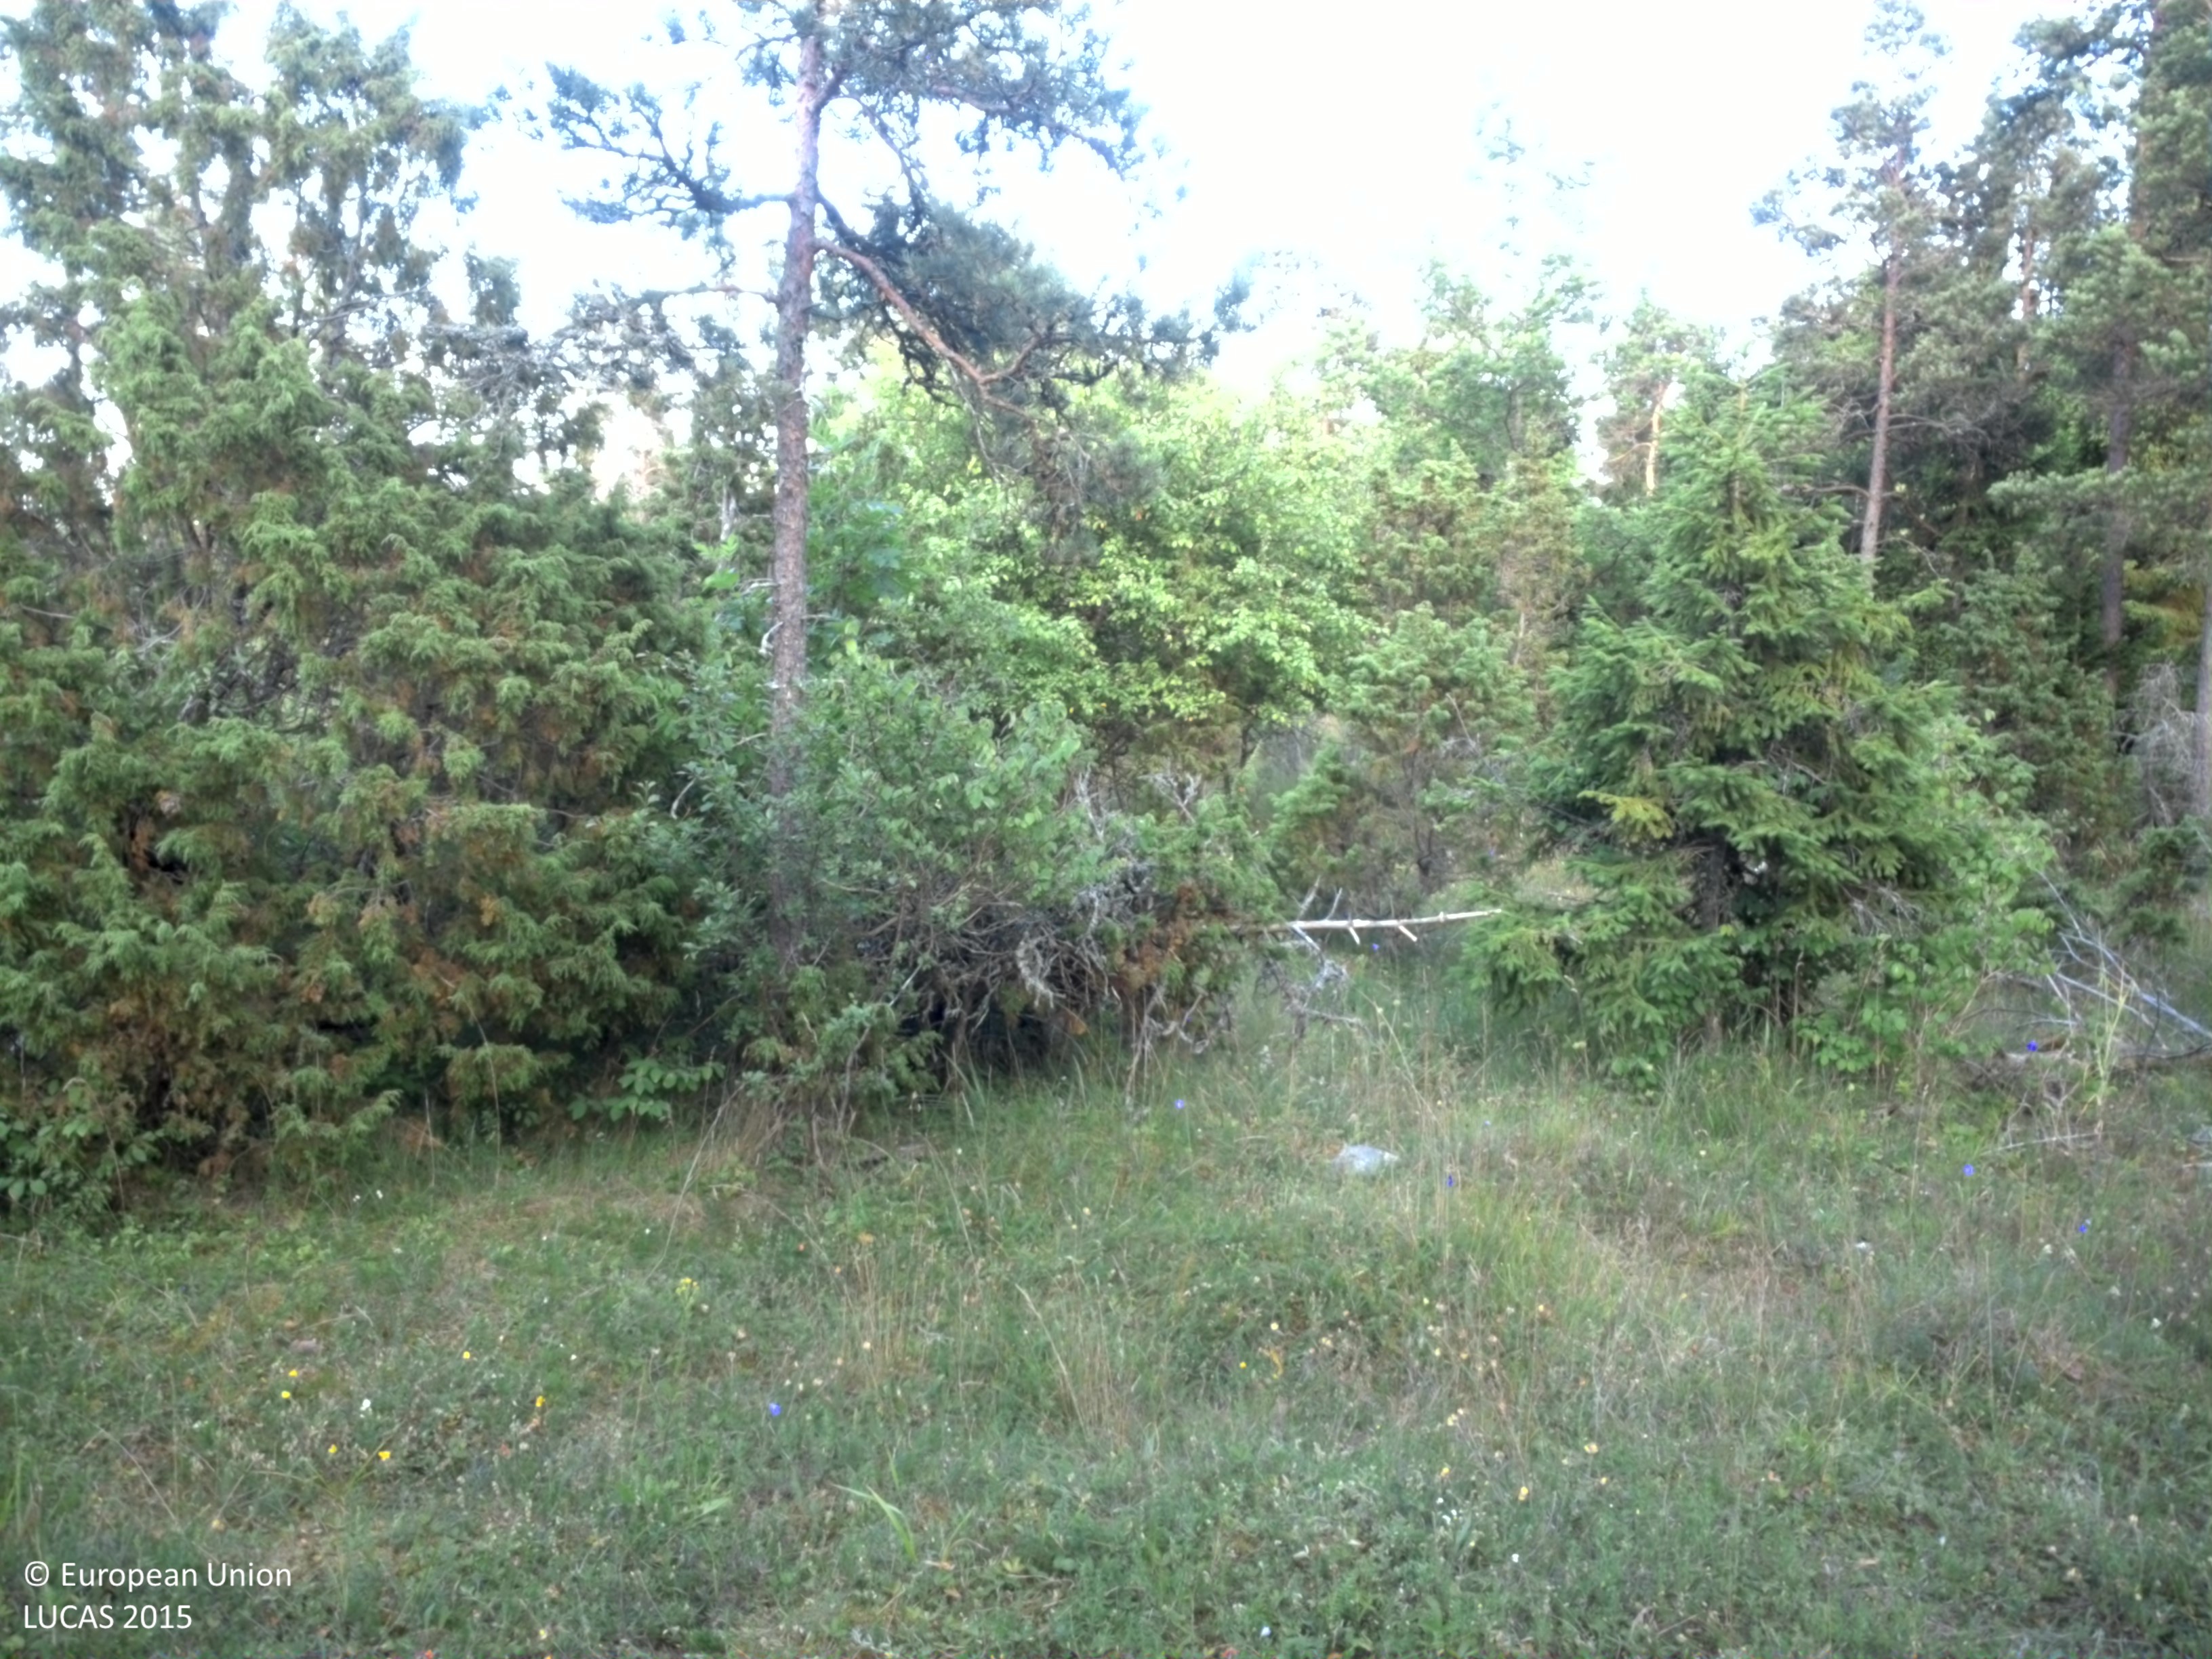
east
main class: Grassland
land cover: Grassland with sparse tree/shrub cover
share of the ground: > 75 %
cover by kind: herbaceous plants 90 %, coniferous forest trees 5 %, shrubs 5 %
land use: Semi-natural and natural areas not in use
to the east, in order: Grassland with sparse tree/shrub cover; Shrubland with sparse tree cover; Grassland with sparse tree/shrub cover; Pine dominated coniferous woodland; Spruce dominated coniferous woodland; Tracks
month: July
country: SE
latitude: 57.5893
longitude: 18.7589
